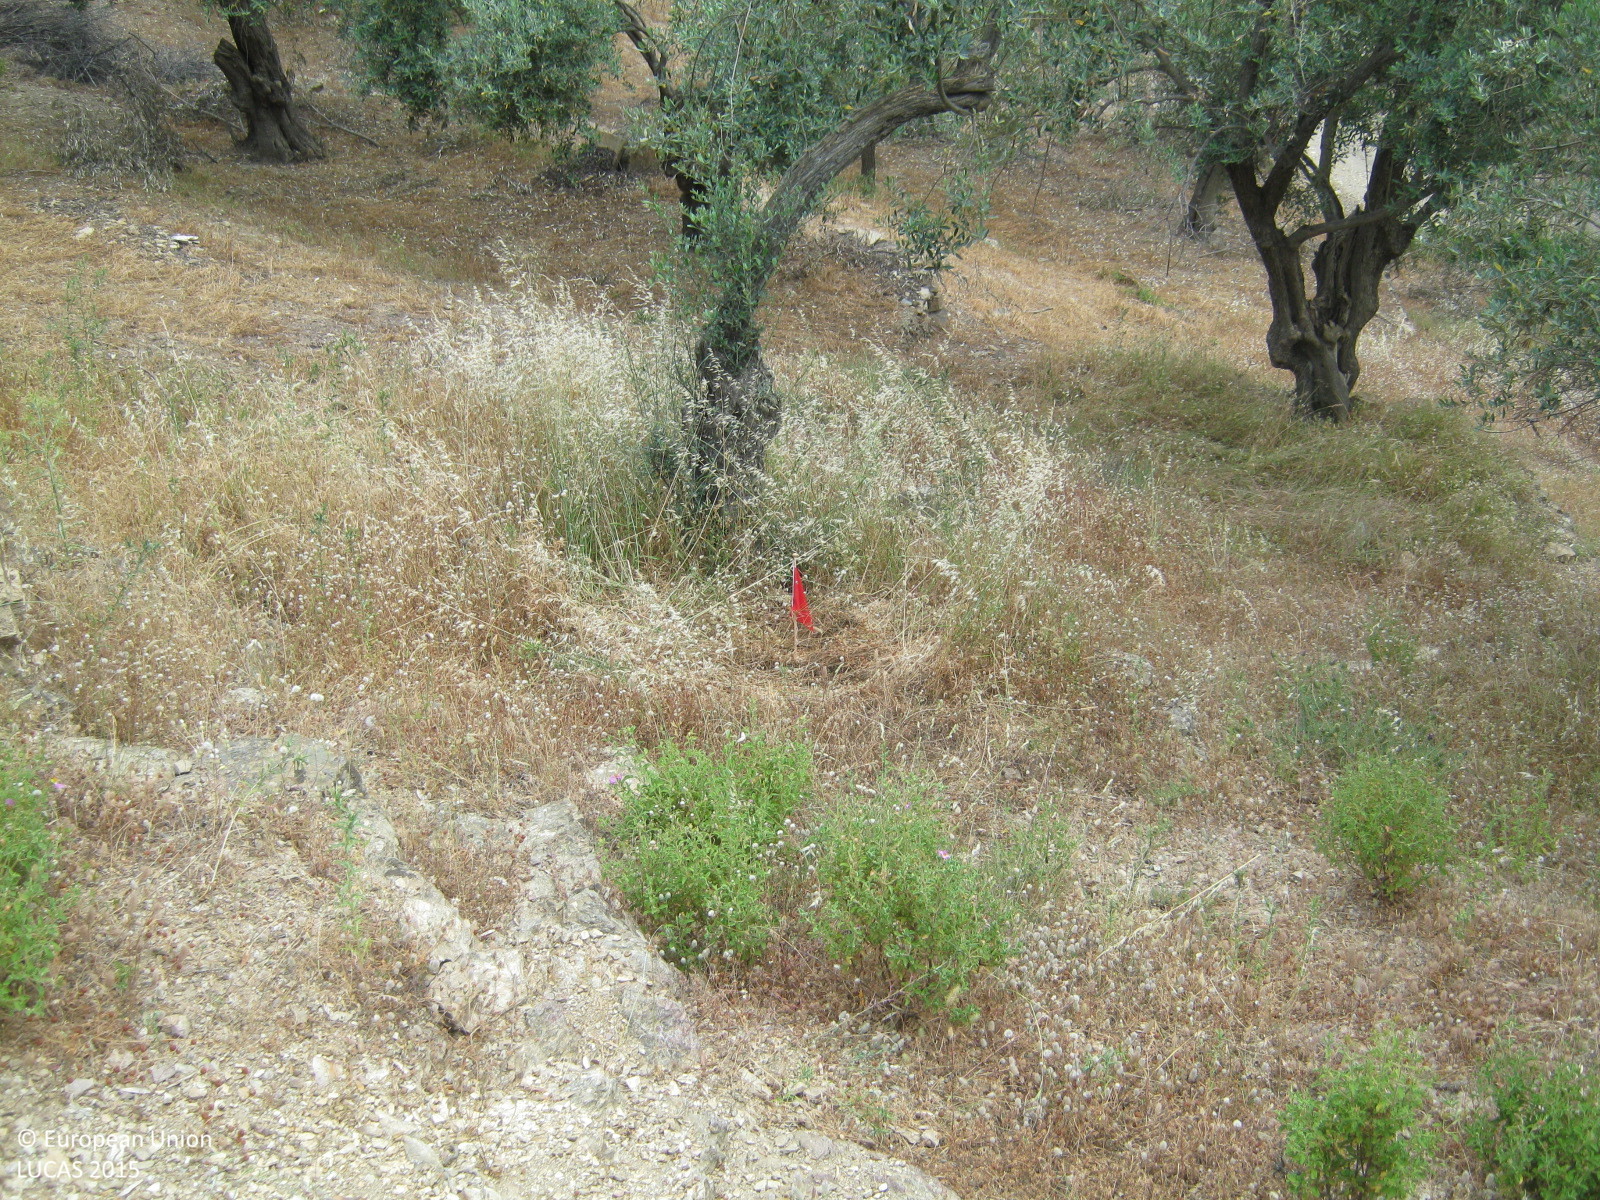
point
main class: Cropland
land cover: Olive groves
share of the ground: > 75 %
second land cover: Spontaneously vegetated surfaces
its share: > 75 %
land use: Agriculture (excluding fallow land and kitchen gardens)
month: May
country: GR
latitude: 38.9763
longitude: 26.4635
